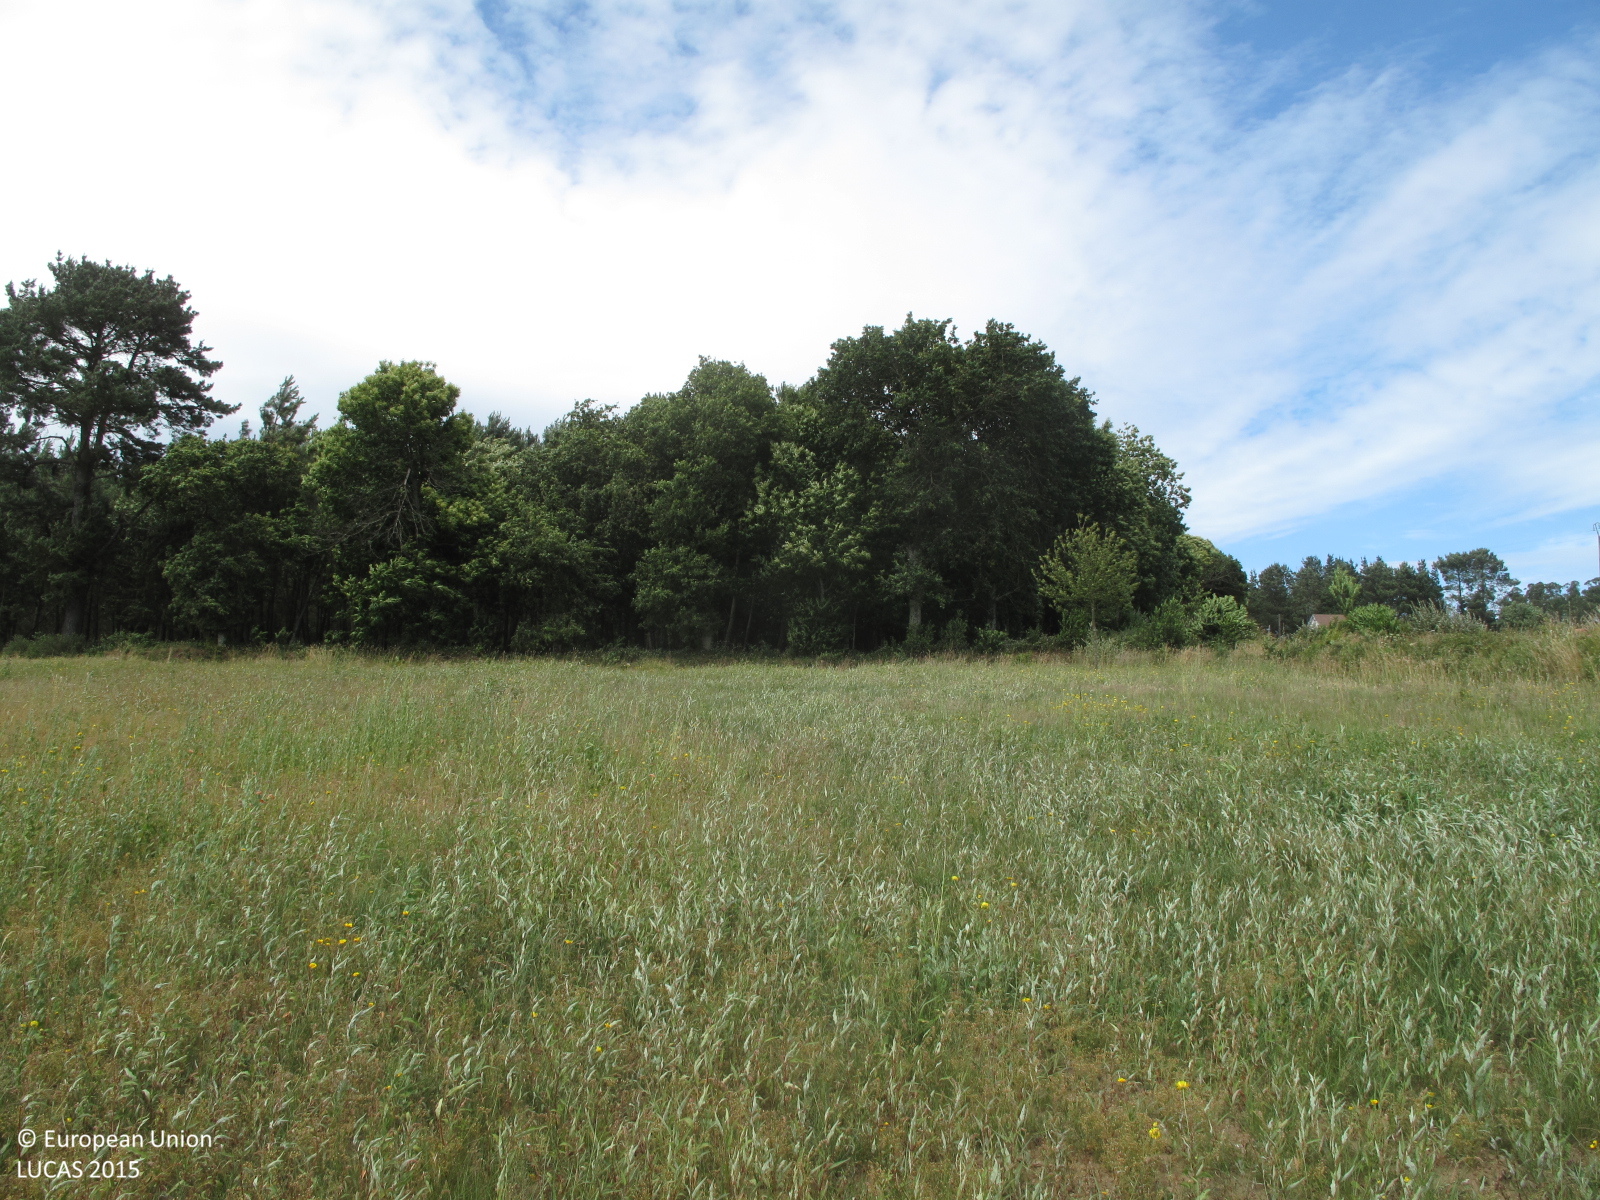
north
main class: Grassland
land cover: Spontaneously vegetated surfaces
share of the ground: 50 - 75 %
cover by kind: herbaceous plants 70 %, unconsolidated bare surface 30 %
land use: Fallow land
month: July
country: ES
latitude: 43.2160
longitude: -8.6387
